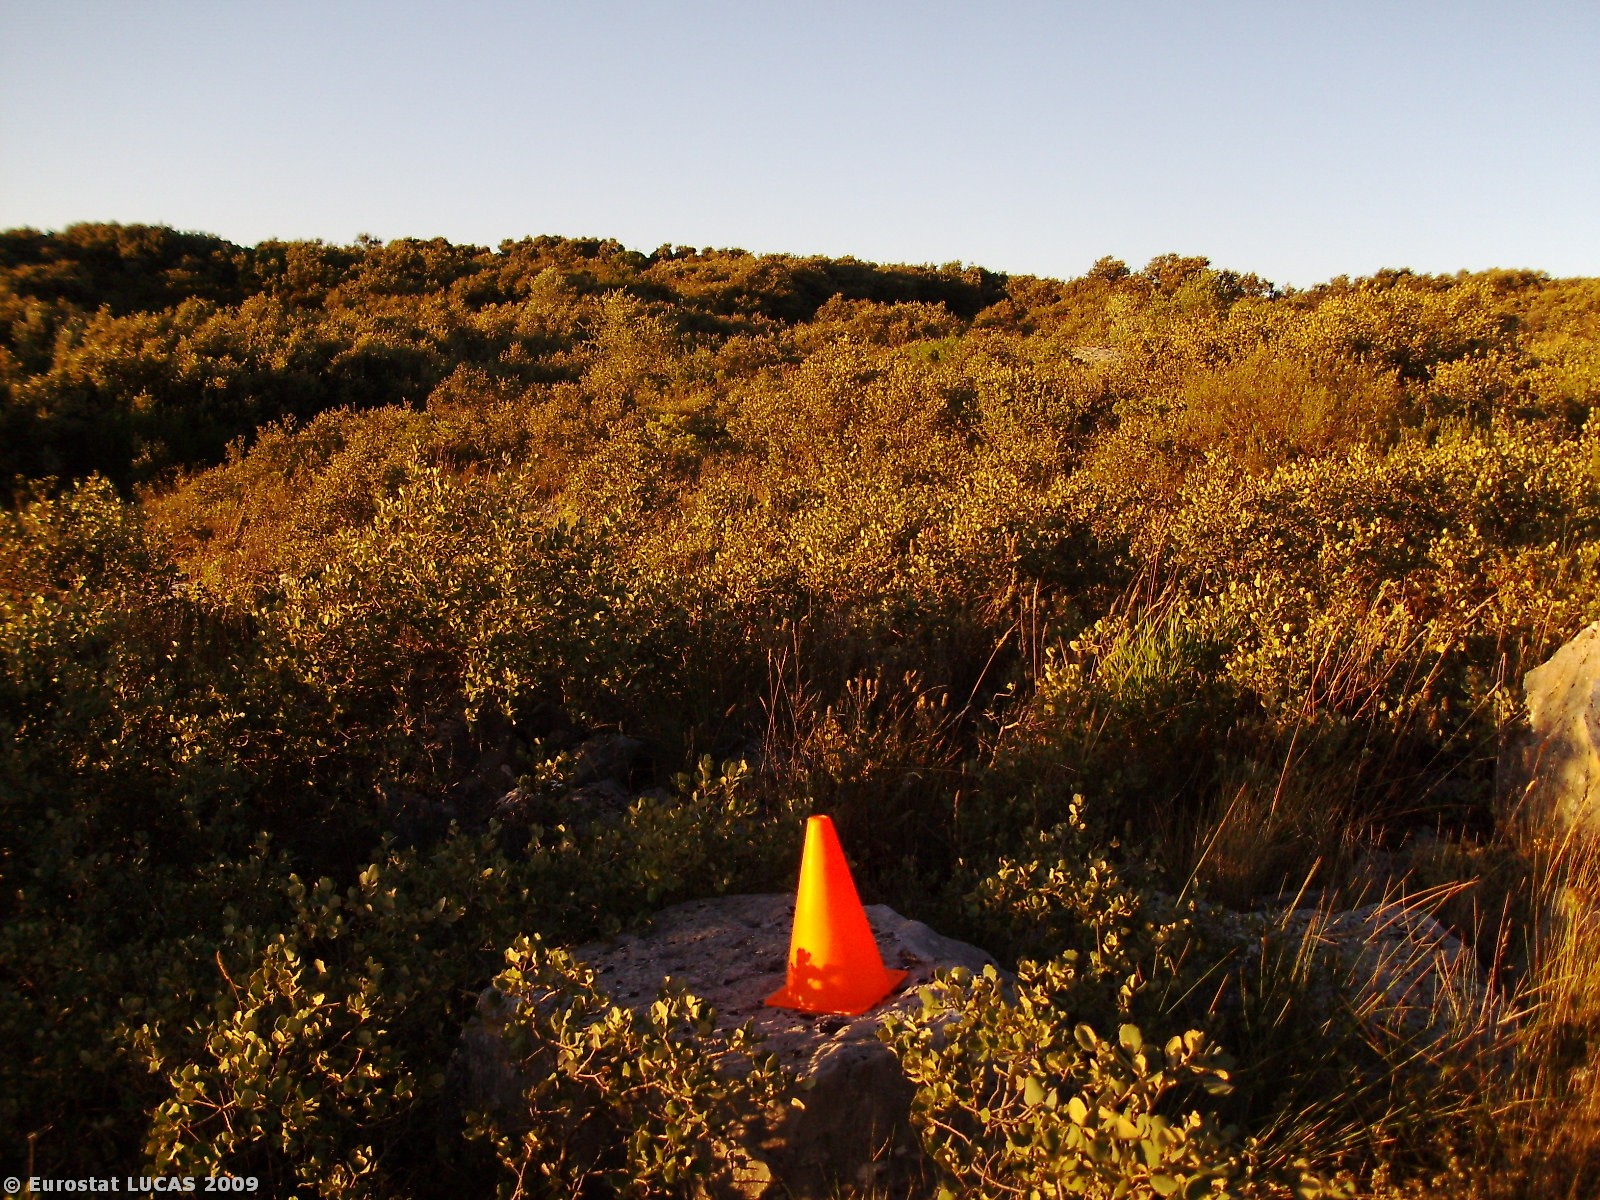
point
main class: Shrubland
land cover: Shrubland without tree cover
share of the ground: > 75 %
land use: Nature reserves
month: July
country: PT
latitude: 39.4671
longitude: -8.8059
